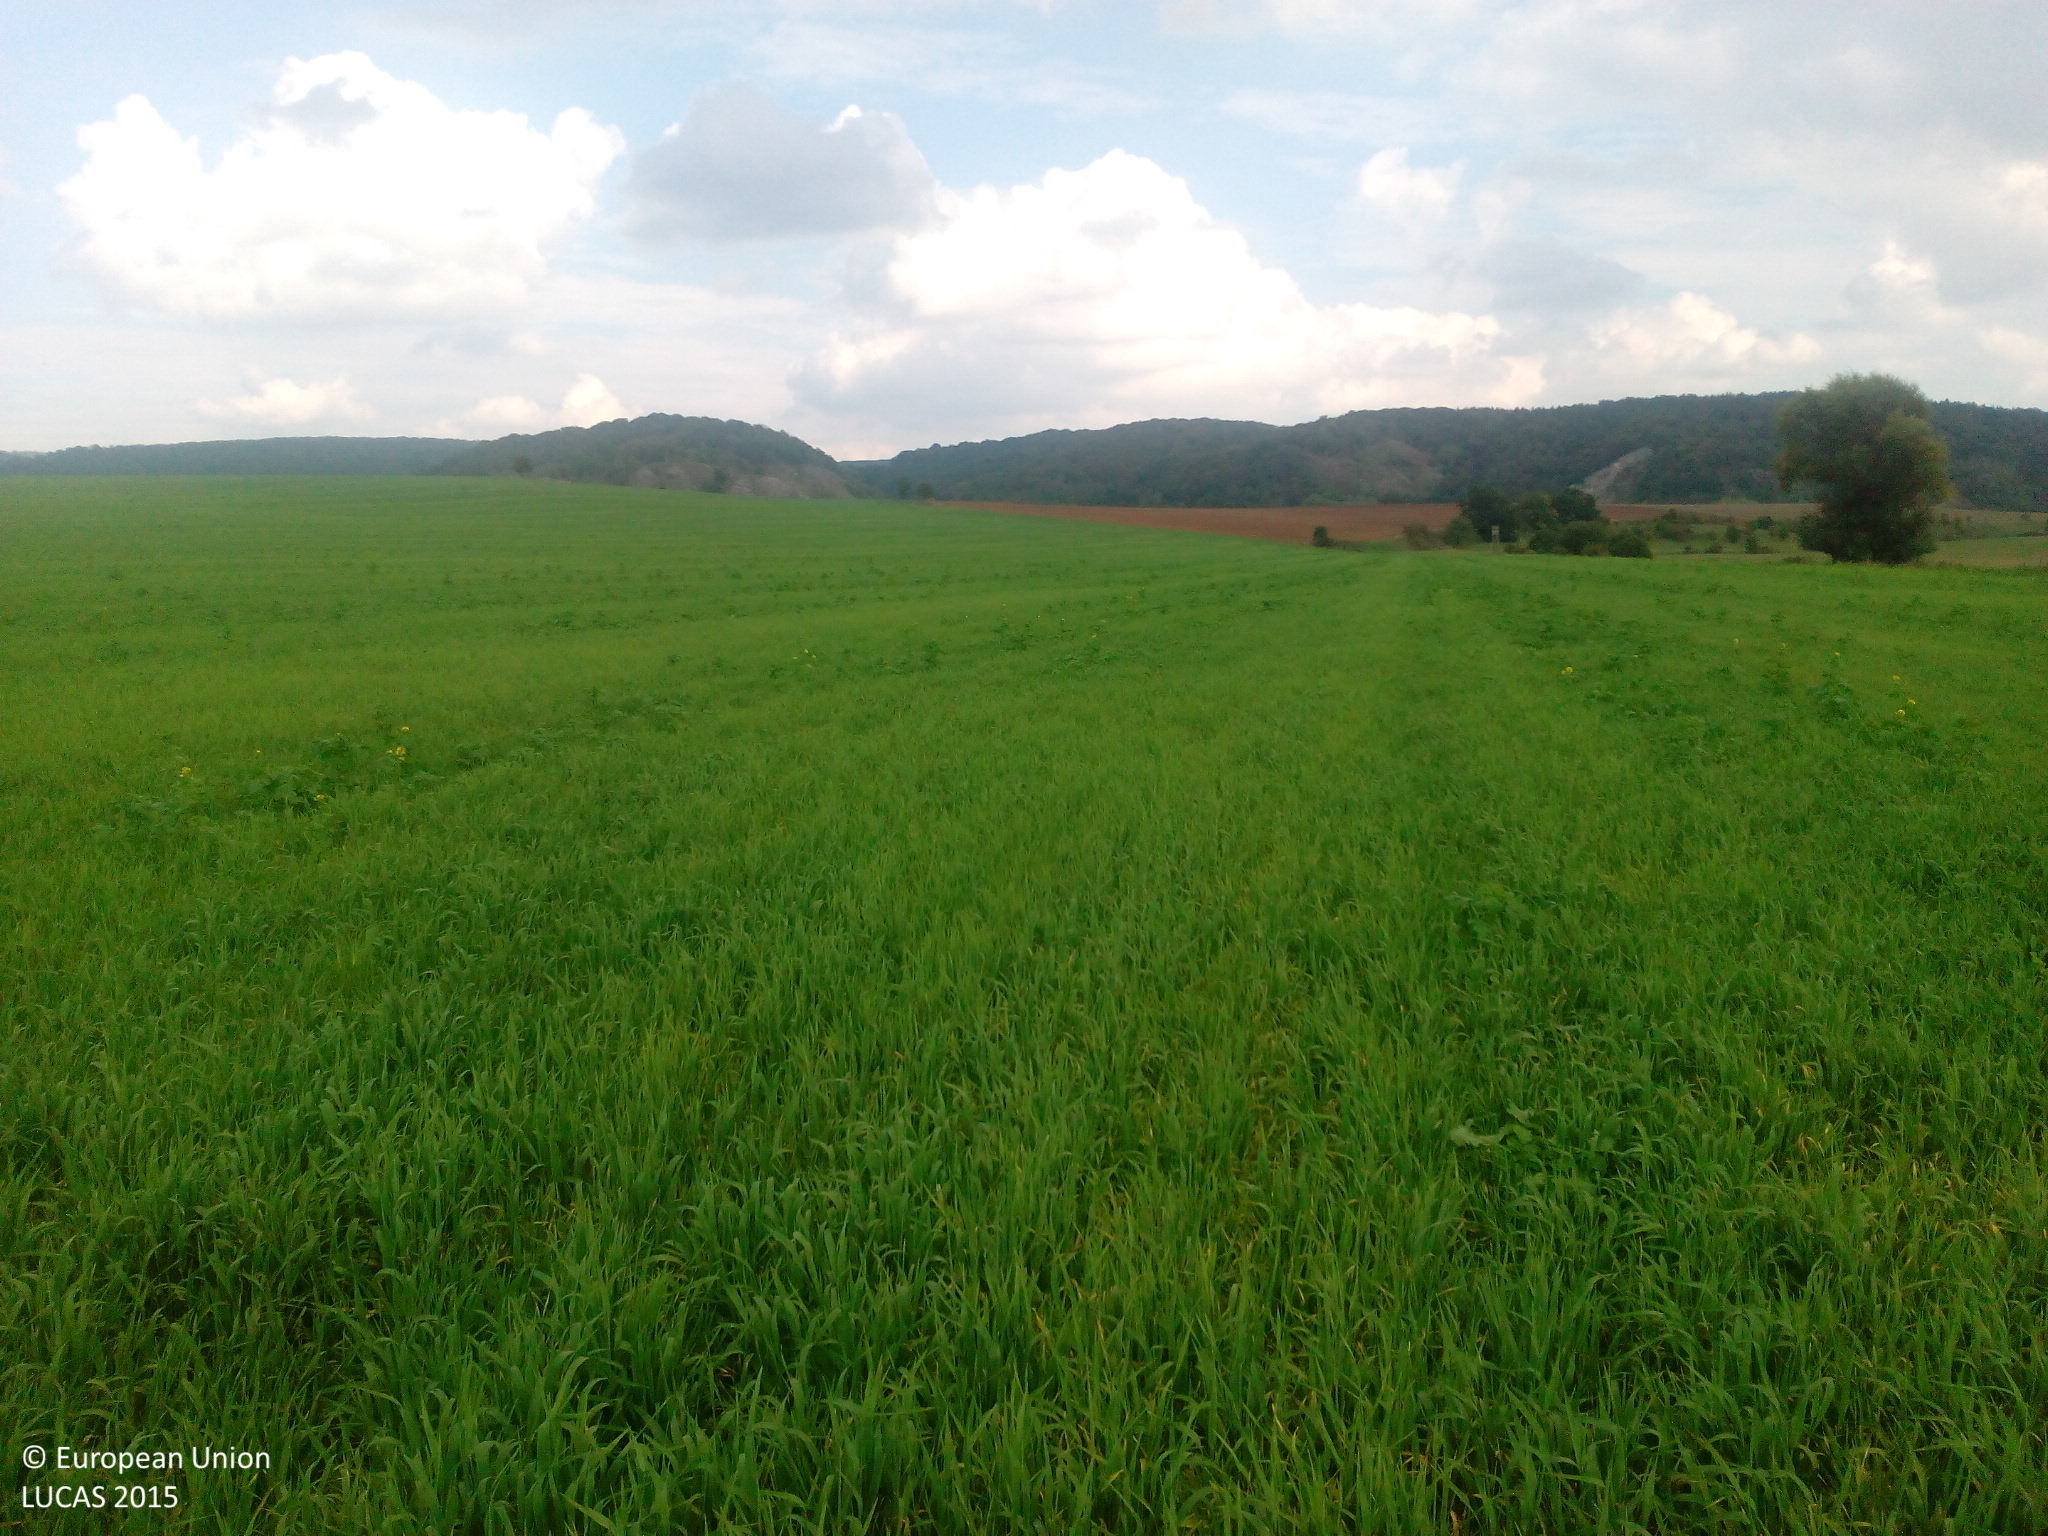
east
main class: Cropland
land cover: Temporary grasslands
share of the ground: > 75 %
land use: Agriculture (excluding fallow land and kitchen gardens)
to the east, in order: Temporary grasslands
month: September
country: DE
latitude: 51.3844
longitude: 11.0199
